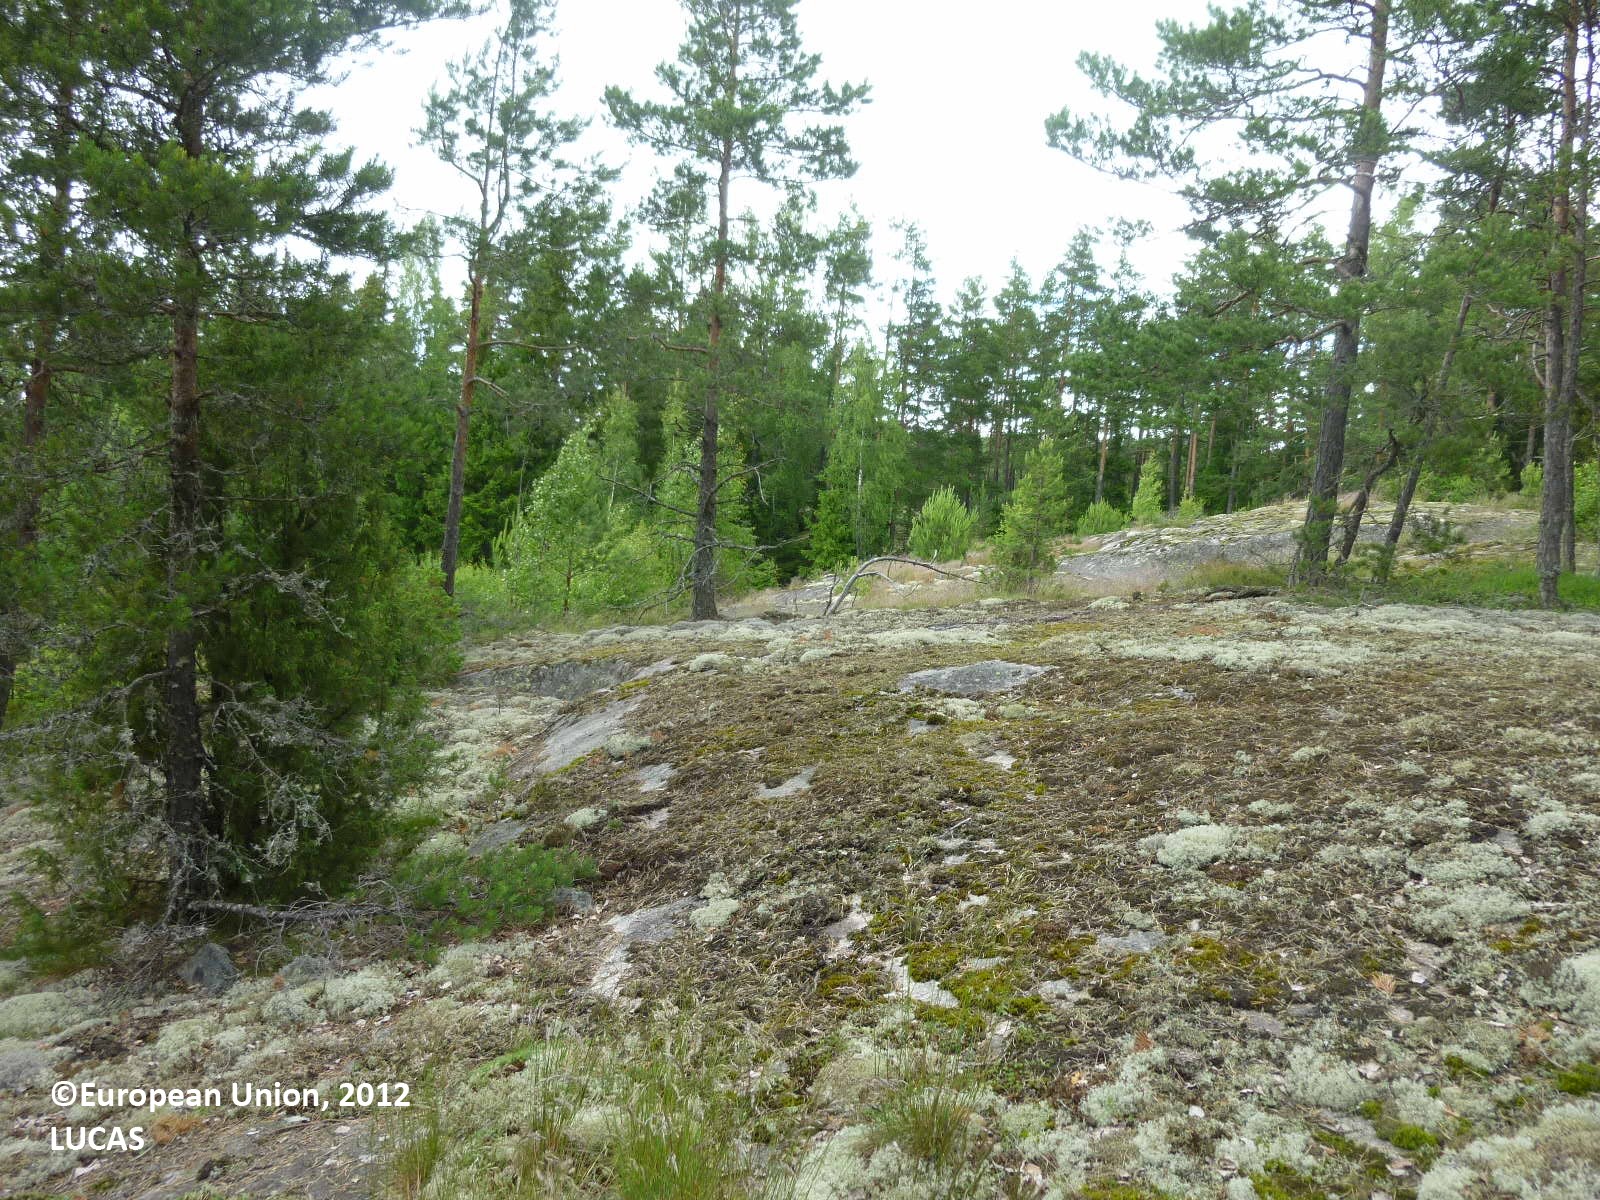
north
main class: Woodland
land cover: Pine dominated coniferous woodland
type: boreal forest
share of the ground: 10 - 25 %
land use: Forestry
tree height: > 5 m
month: June
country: FI
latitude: 60.2798
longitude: 22.4946
